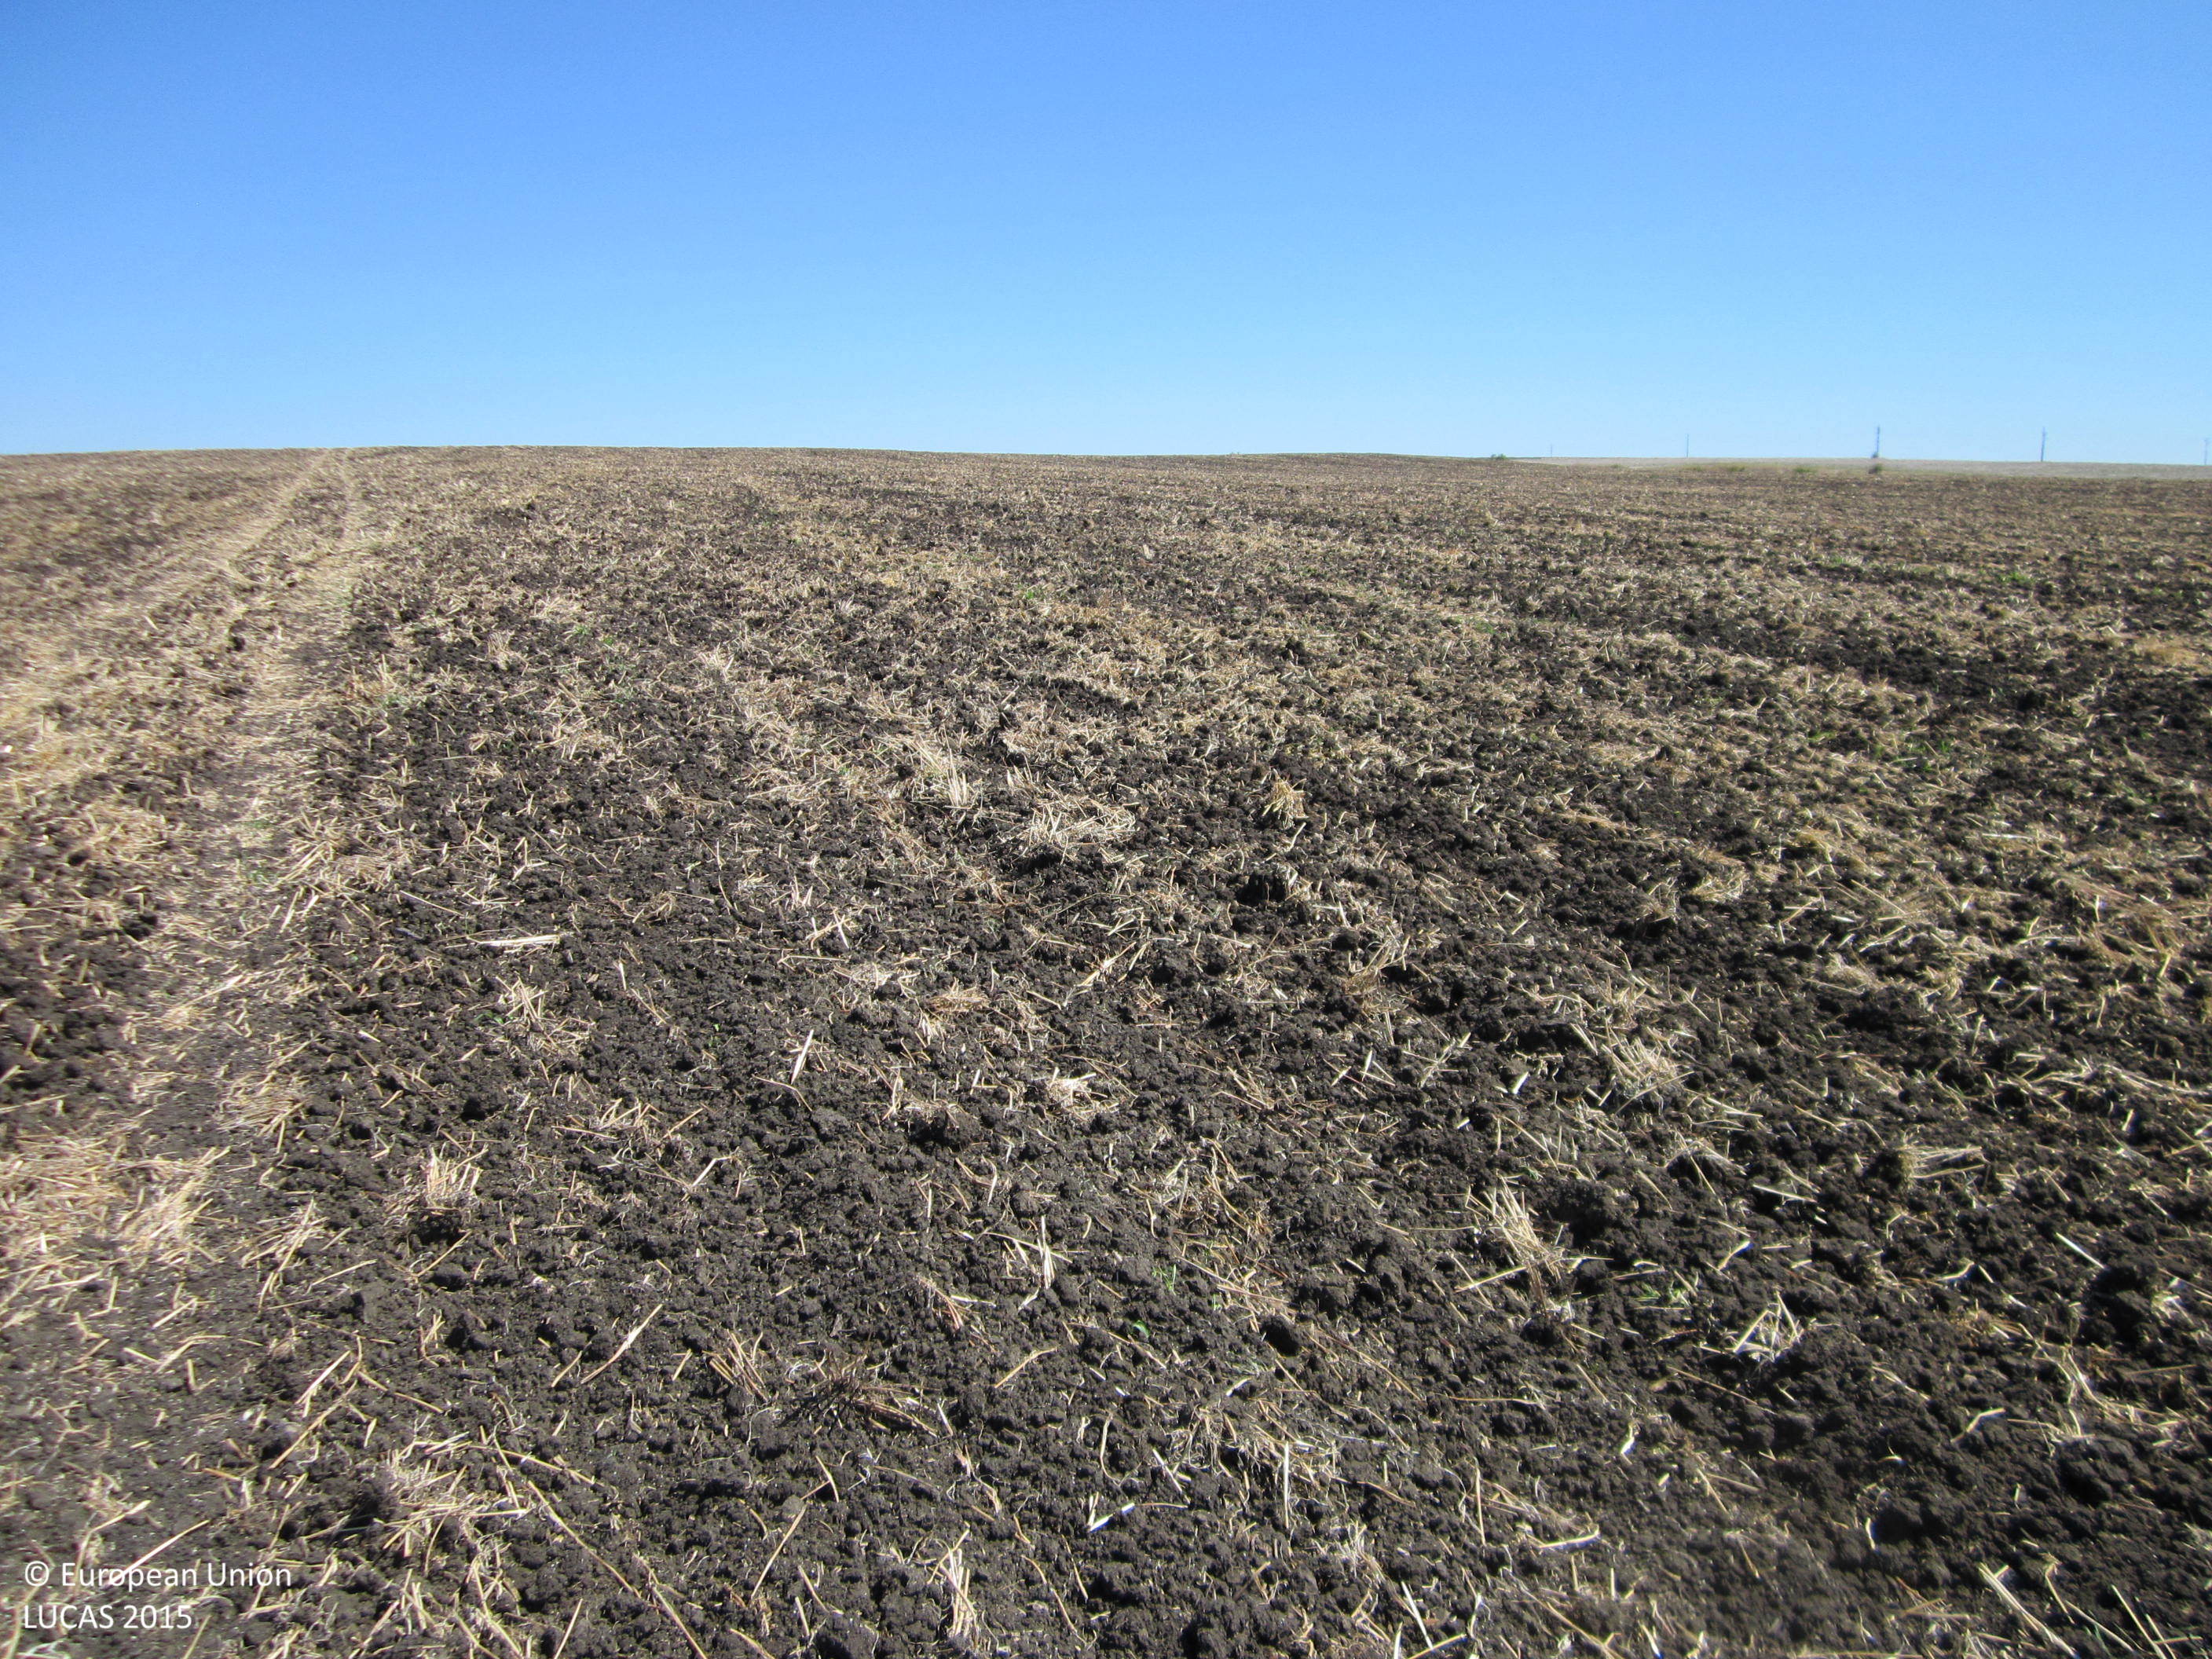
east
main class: Cropland
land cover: Common wheat
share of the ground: 10 - 25 %
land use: Agriculture (excluding fallow land and kitchen gardens)
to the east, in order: Common wheat
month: September
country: BG
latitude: 42.5587
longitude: 27.0490
